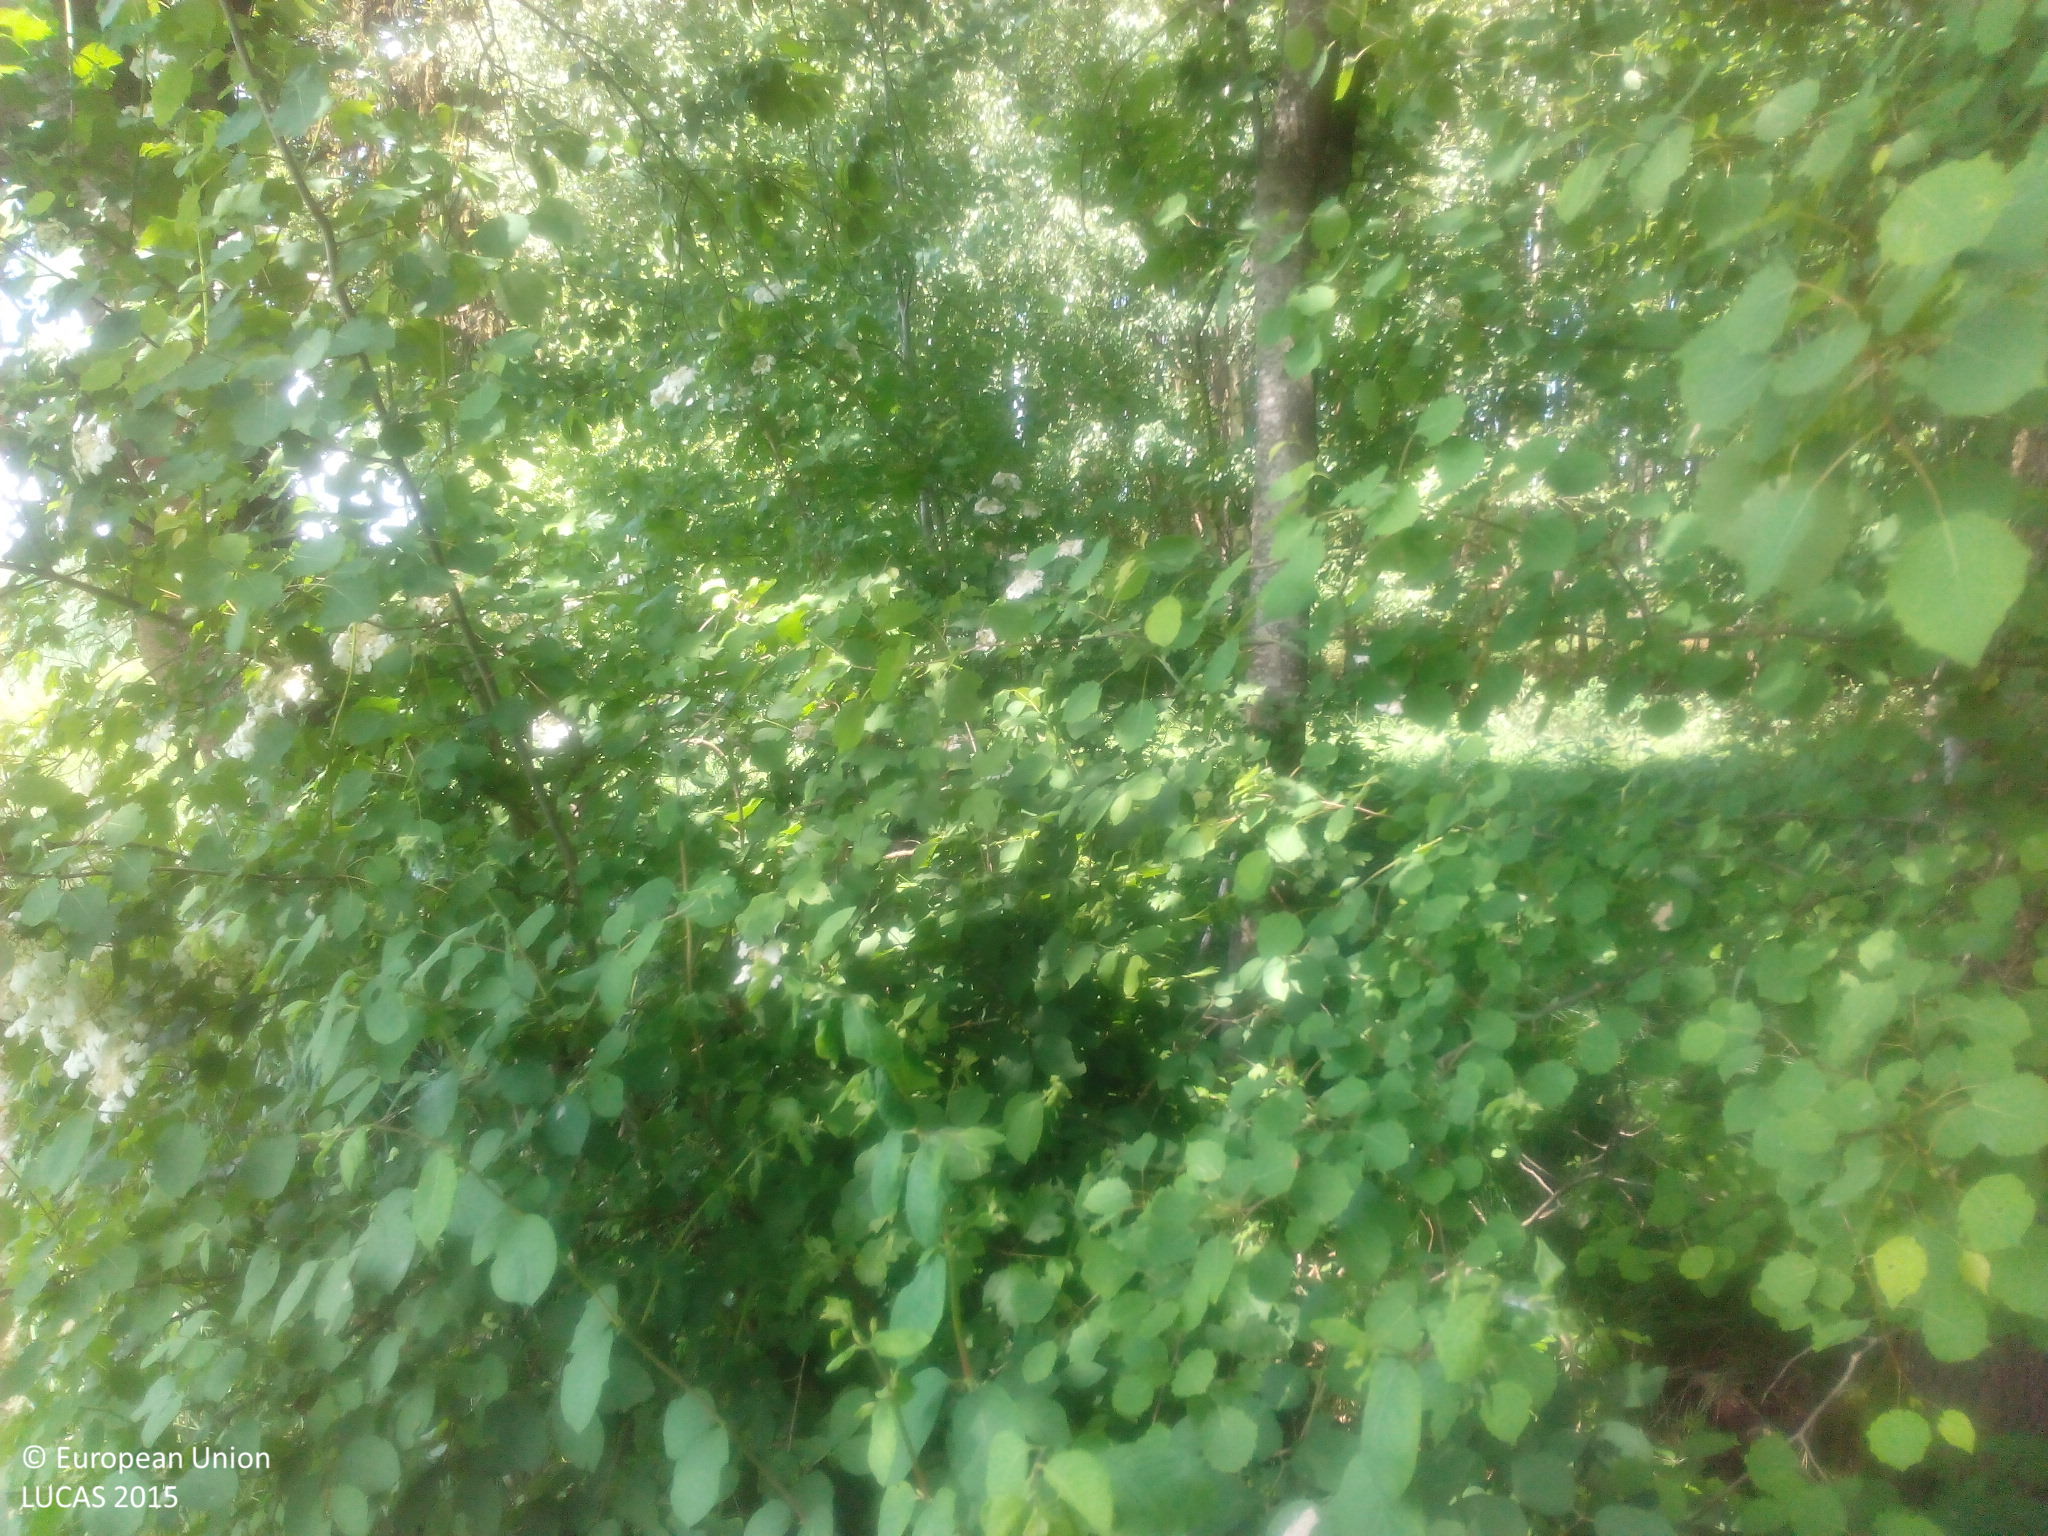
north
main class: Woodland
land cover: Broadleaved woodland
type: mesophytic deciduous forest
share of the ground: > 75 %
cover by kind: broadleaved forest trees 80 %, shrubs 10 %, herbaceous plants 10 %
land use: Forestry
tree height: > 5 m
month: June
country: DE
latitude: 48.4316
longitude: 12.3913
